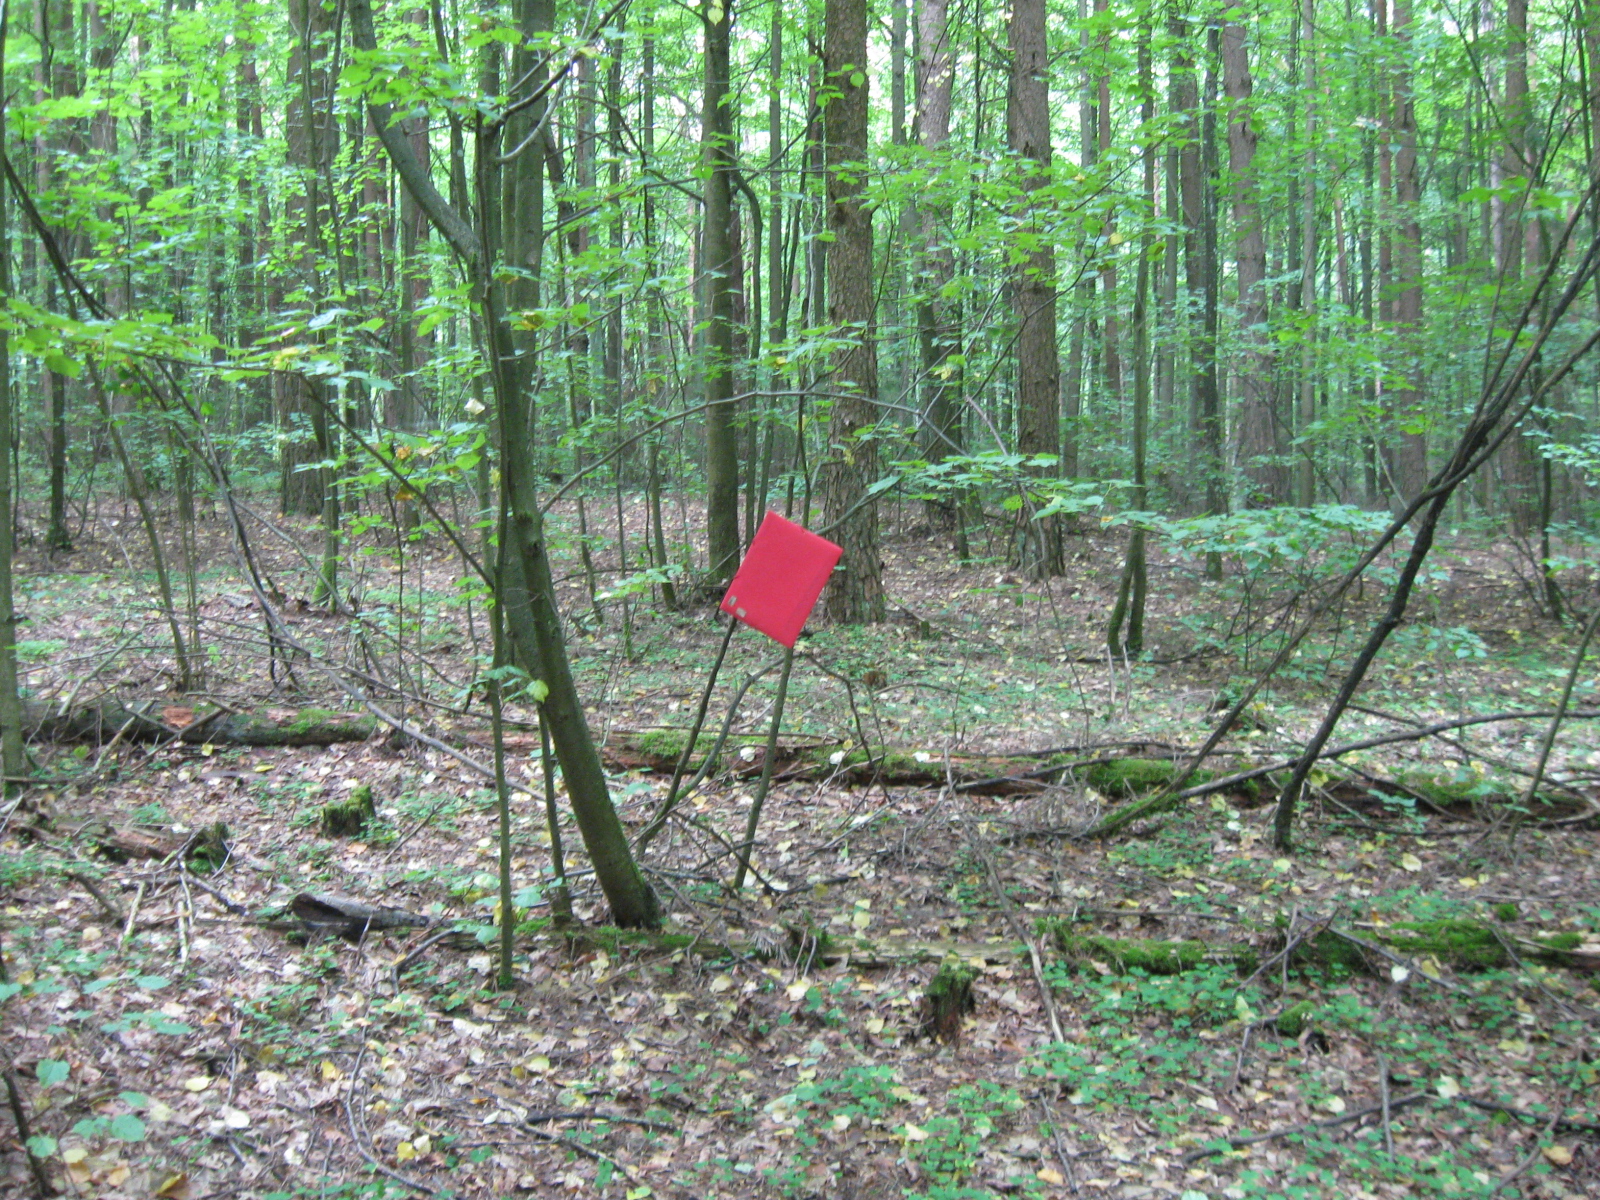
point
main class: Woodland
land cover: Pine dominated mixed woodland
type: hemiboreal forest and nemoral coniferous forest and mixed broadleaved-coniferous forest
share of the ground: > 75 %
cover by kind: broadleaved forest trees 45 %, coniferous forest trees 40 %, unconsolidated bare surface 10 %, herbaceous plants 5 %
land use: Forestry
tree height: > 5 m
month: July
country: LT
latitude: 55.0196
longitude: 23.6119
